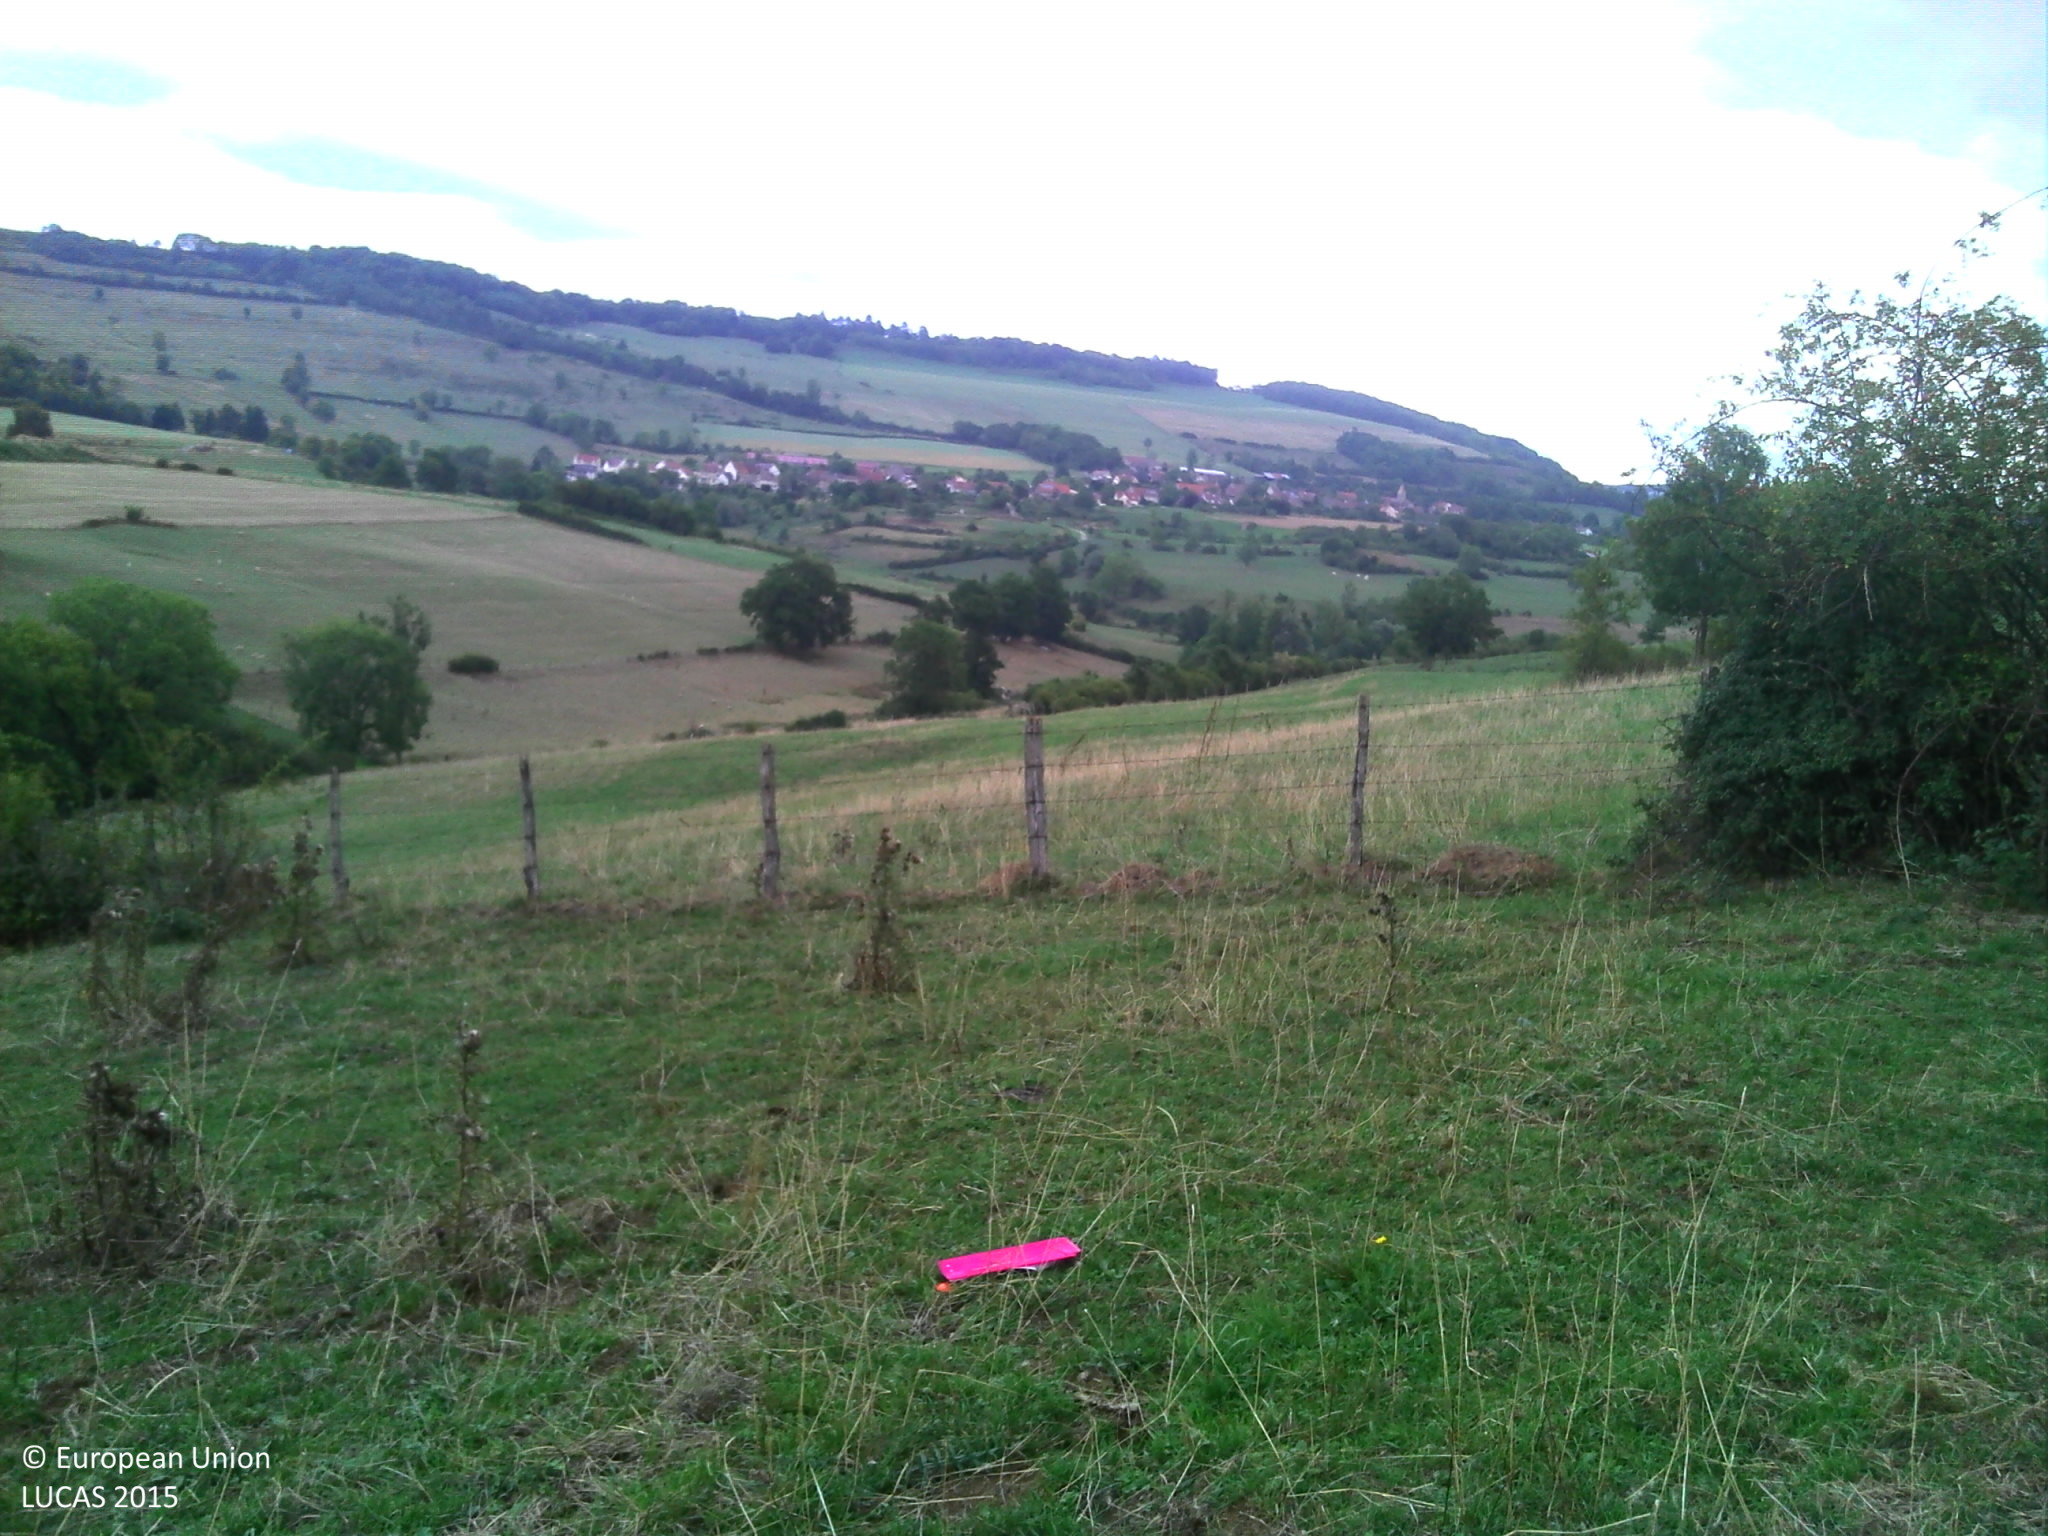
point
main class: Grassland
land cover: Grassland without tree/shrub cover
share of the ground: > 75 %
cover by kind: herbaceous plants 100 %
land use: Agriculture (excluding fallow land and kitchen gardens)
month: August
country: FR
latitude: 47.3228
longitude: 4.7473
